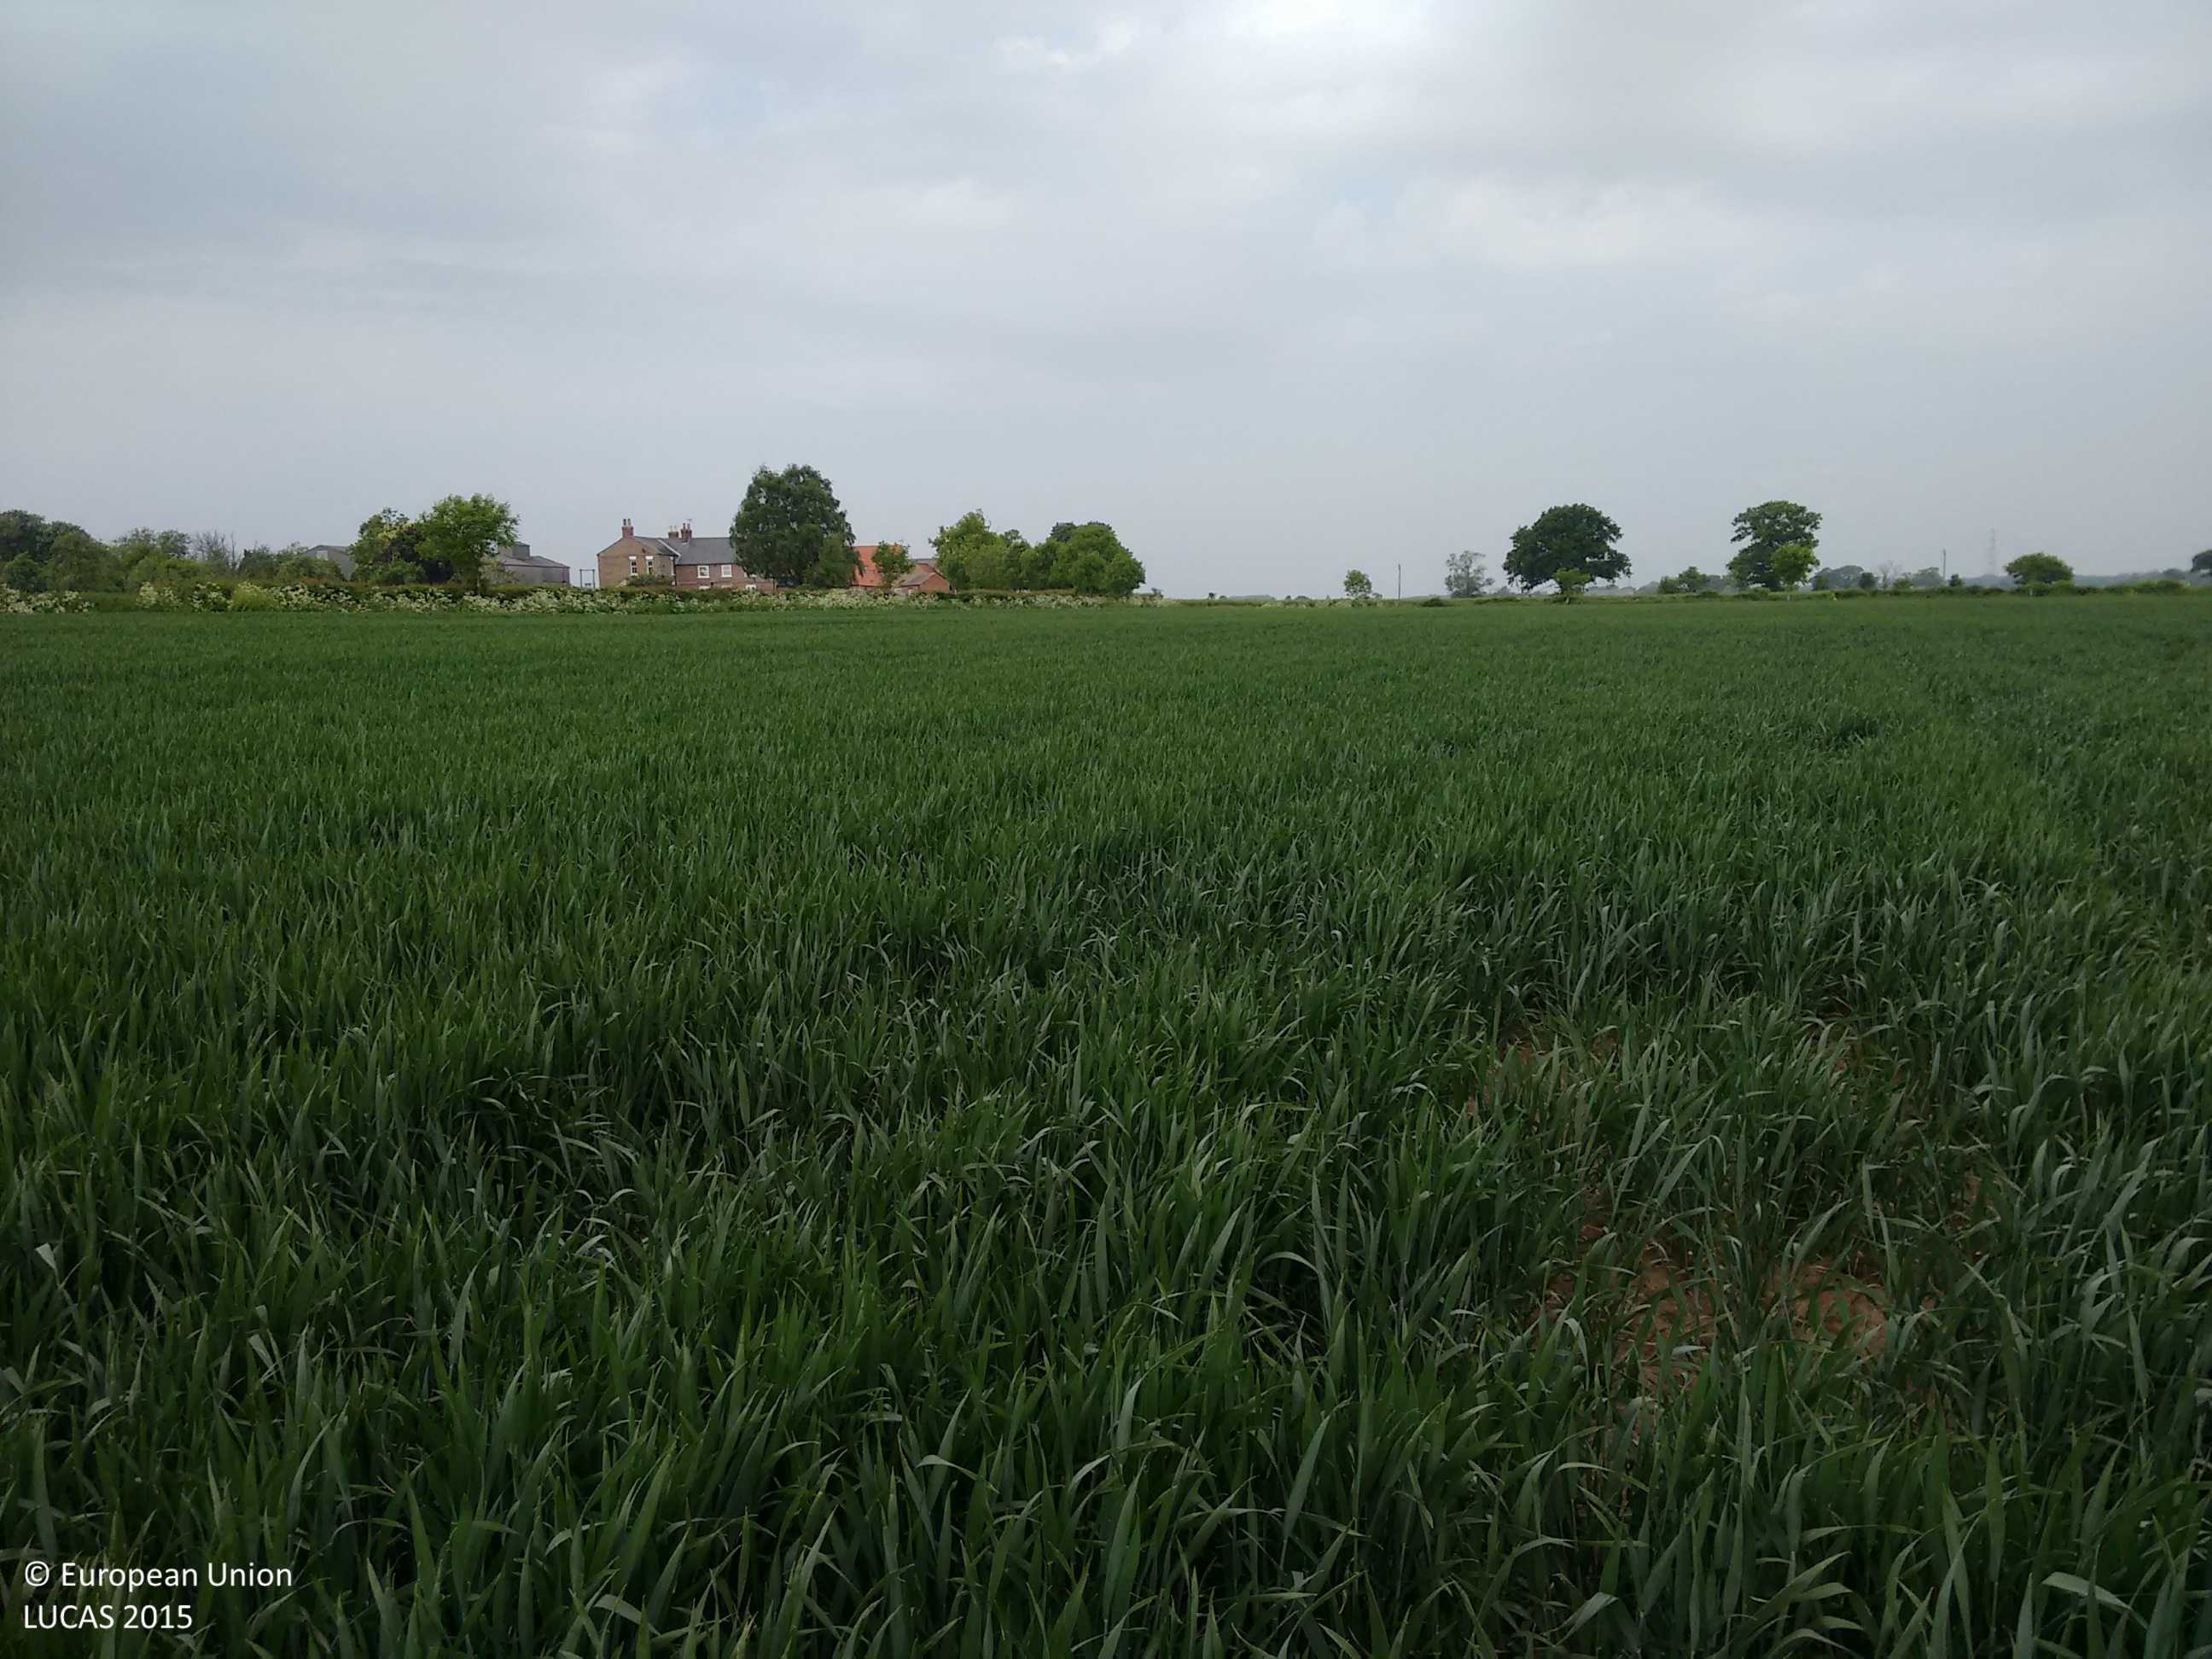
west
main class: Cropland
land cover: Common wheat
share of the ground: > 75 %
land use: Agriculture (excluding fallow land and kitchen gardens)
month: November
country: GB
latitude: 53.9915
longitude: -1.1639
